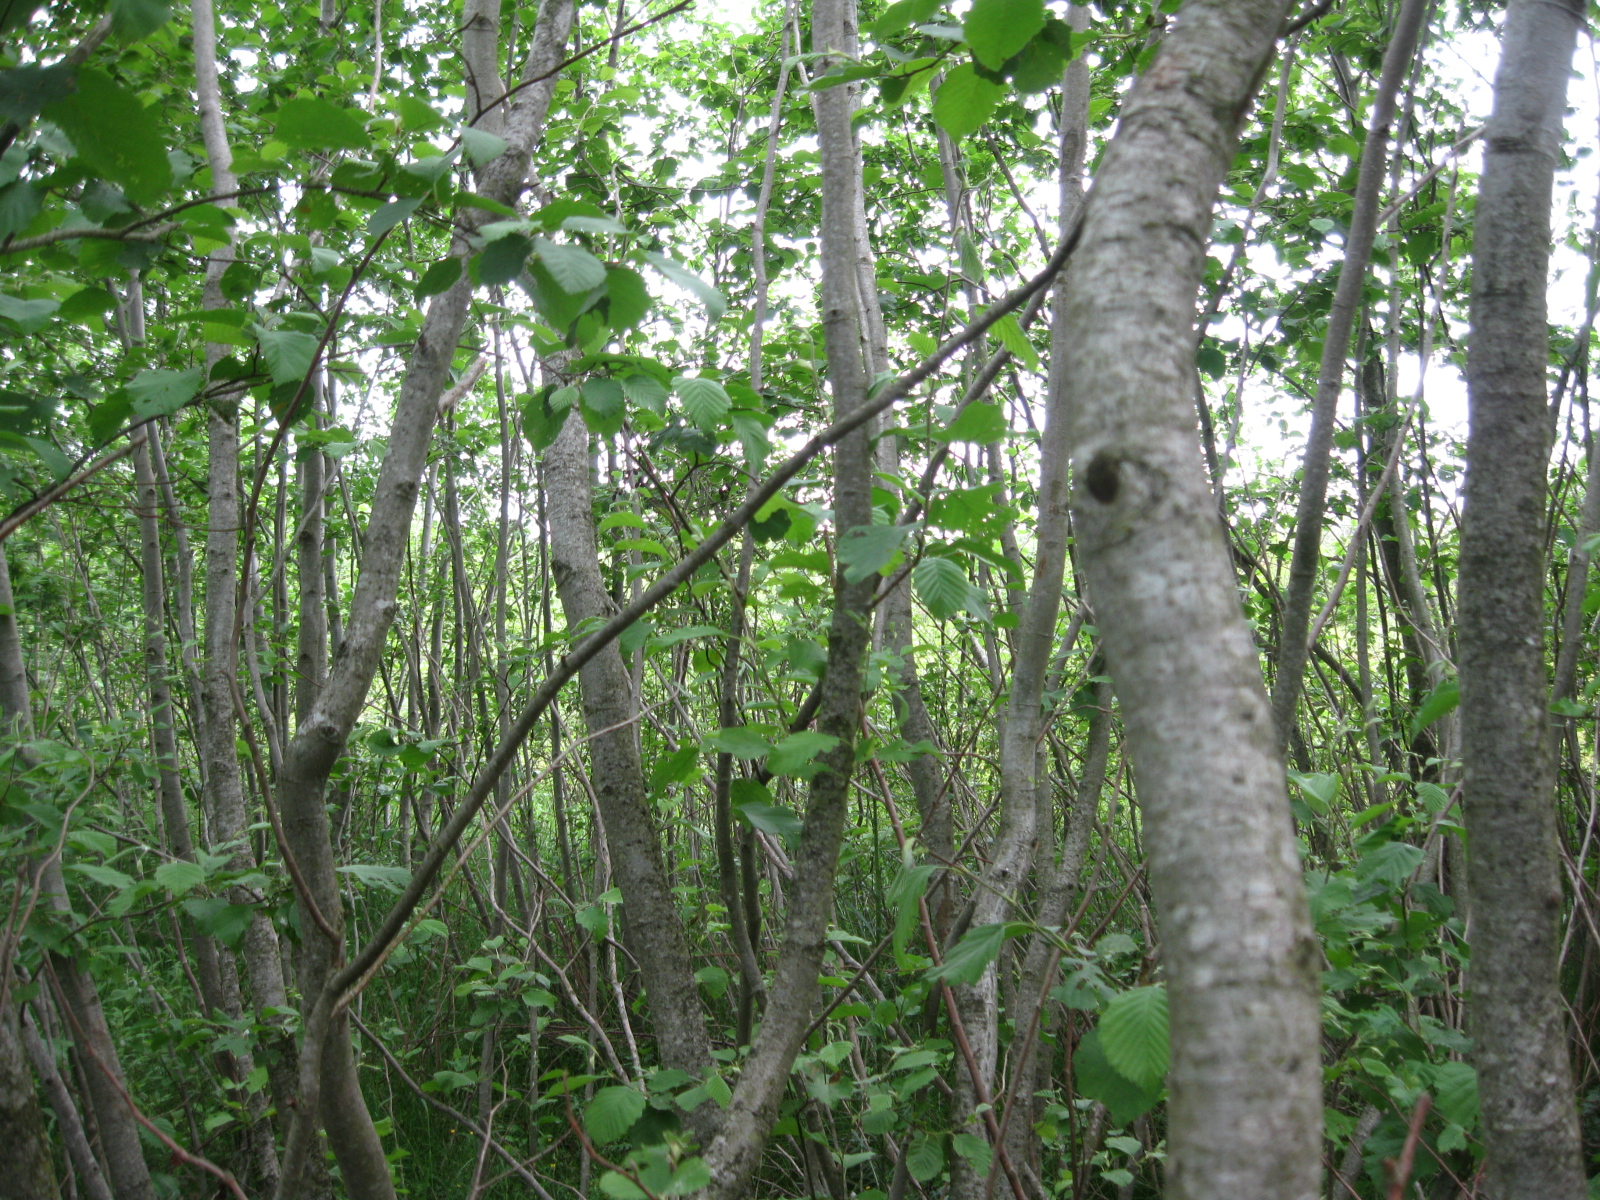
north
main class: Woodland
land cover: Broadleaved woodland
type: floodplain forest
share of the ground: 50 - 75 %
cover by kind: broadleaved forest trees 65 %, herbaceous plants 25 %, shrubs 10 %
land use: Semi-natural and natural areas not in use
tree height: > 5 m
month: June
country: LT
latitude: 55.3214
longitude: 23.5228
